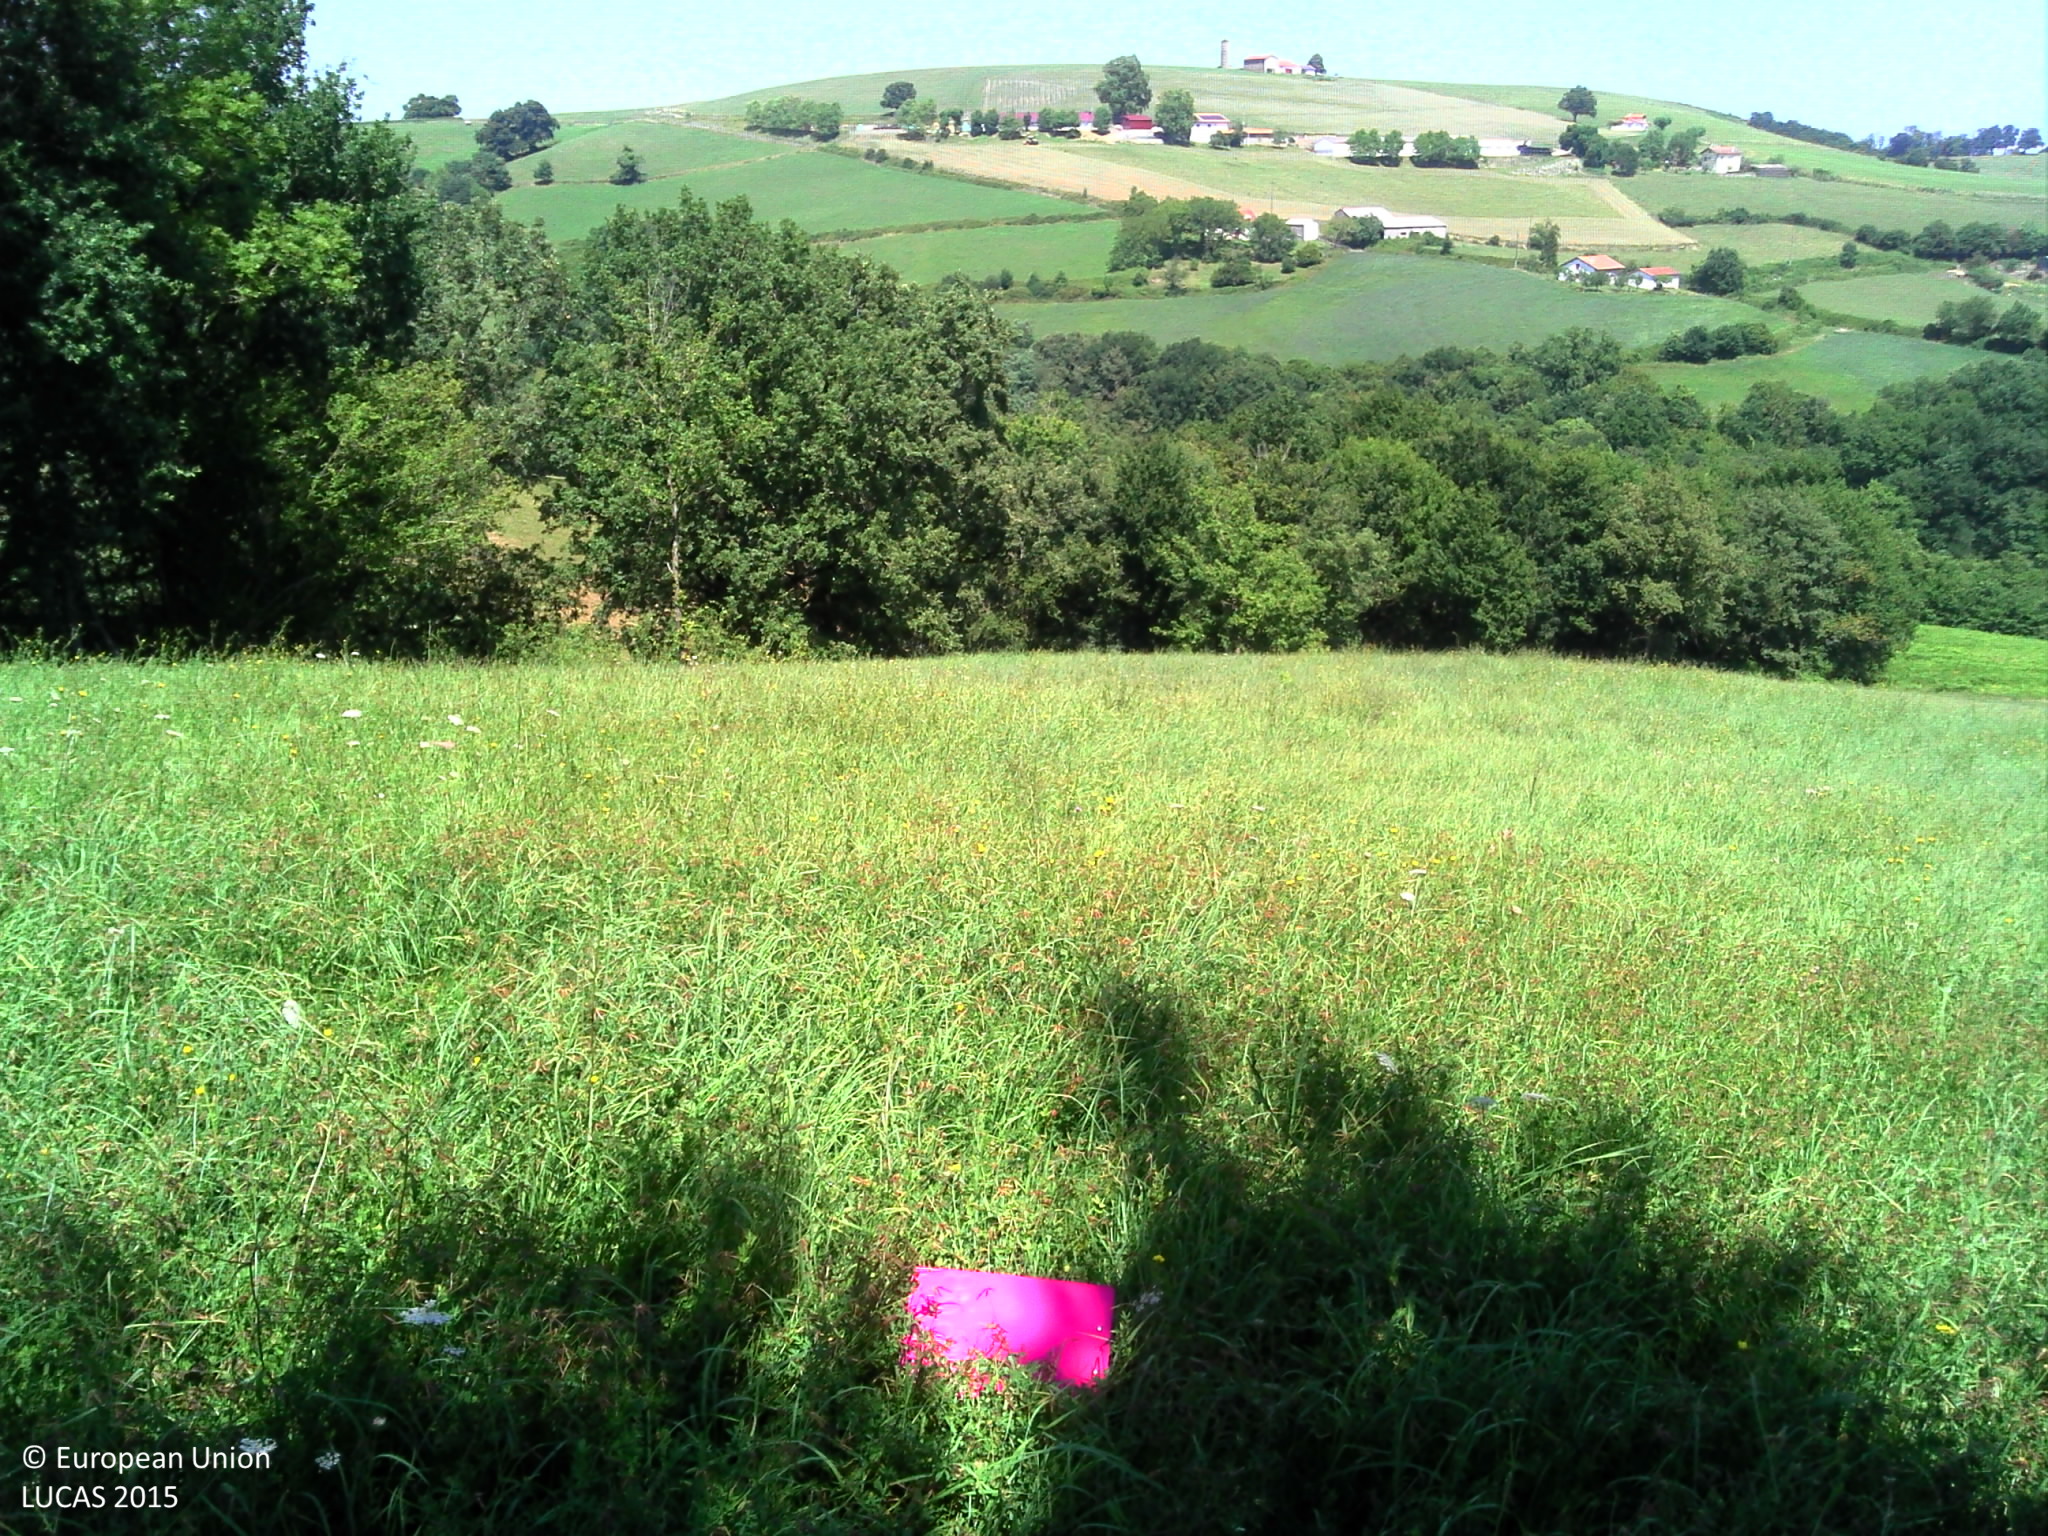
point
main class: Cropland
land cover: Temporary grasslands
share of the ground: > 75 %
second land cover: Lucerne
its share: 10 - 25 %
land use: Agriculture (excluding fallow land and kitchen gardens)
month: August
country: FR
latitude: 43.3167
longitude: -1.0981
